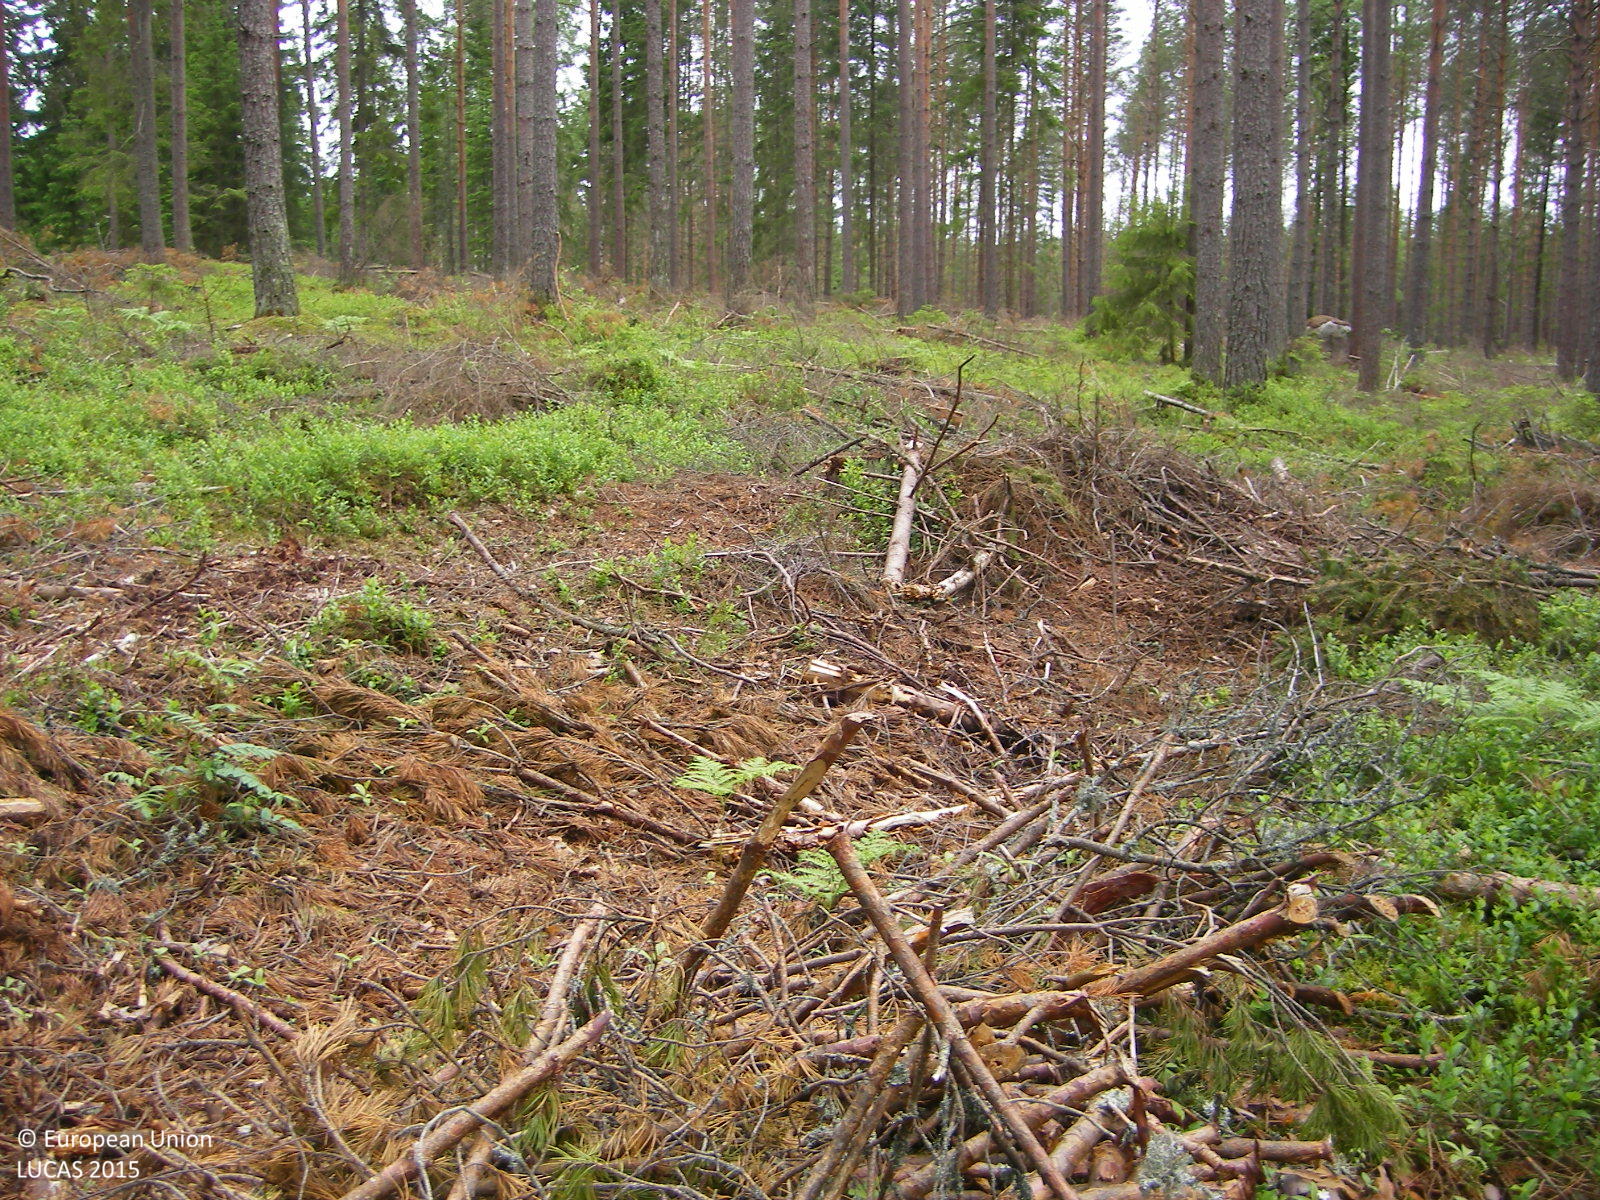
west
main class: Woodland
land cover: Other coniferous woodland
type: boreal forest
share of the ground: 50 - 75 %
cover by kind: coniferous forest trees 60 %, shrubs 25 %, unconsolidated bare surface 10 %, lichens and mosses 5 %
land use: Forestry
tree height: > 5 m
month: June
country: FI
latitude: 60.2434
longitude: 23.2887
